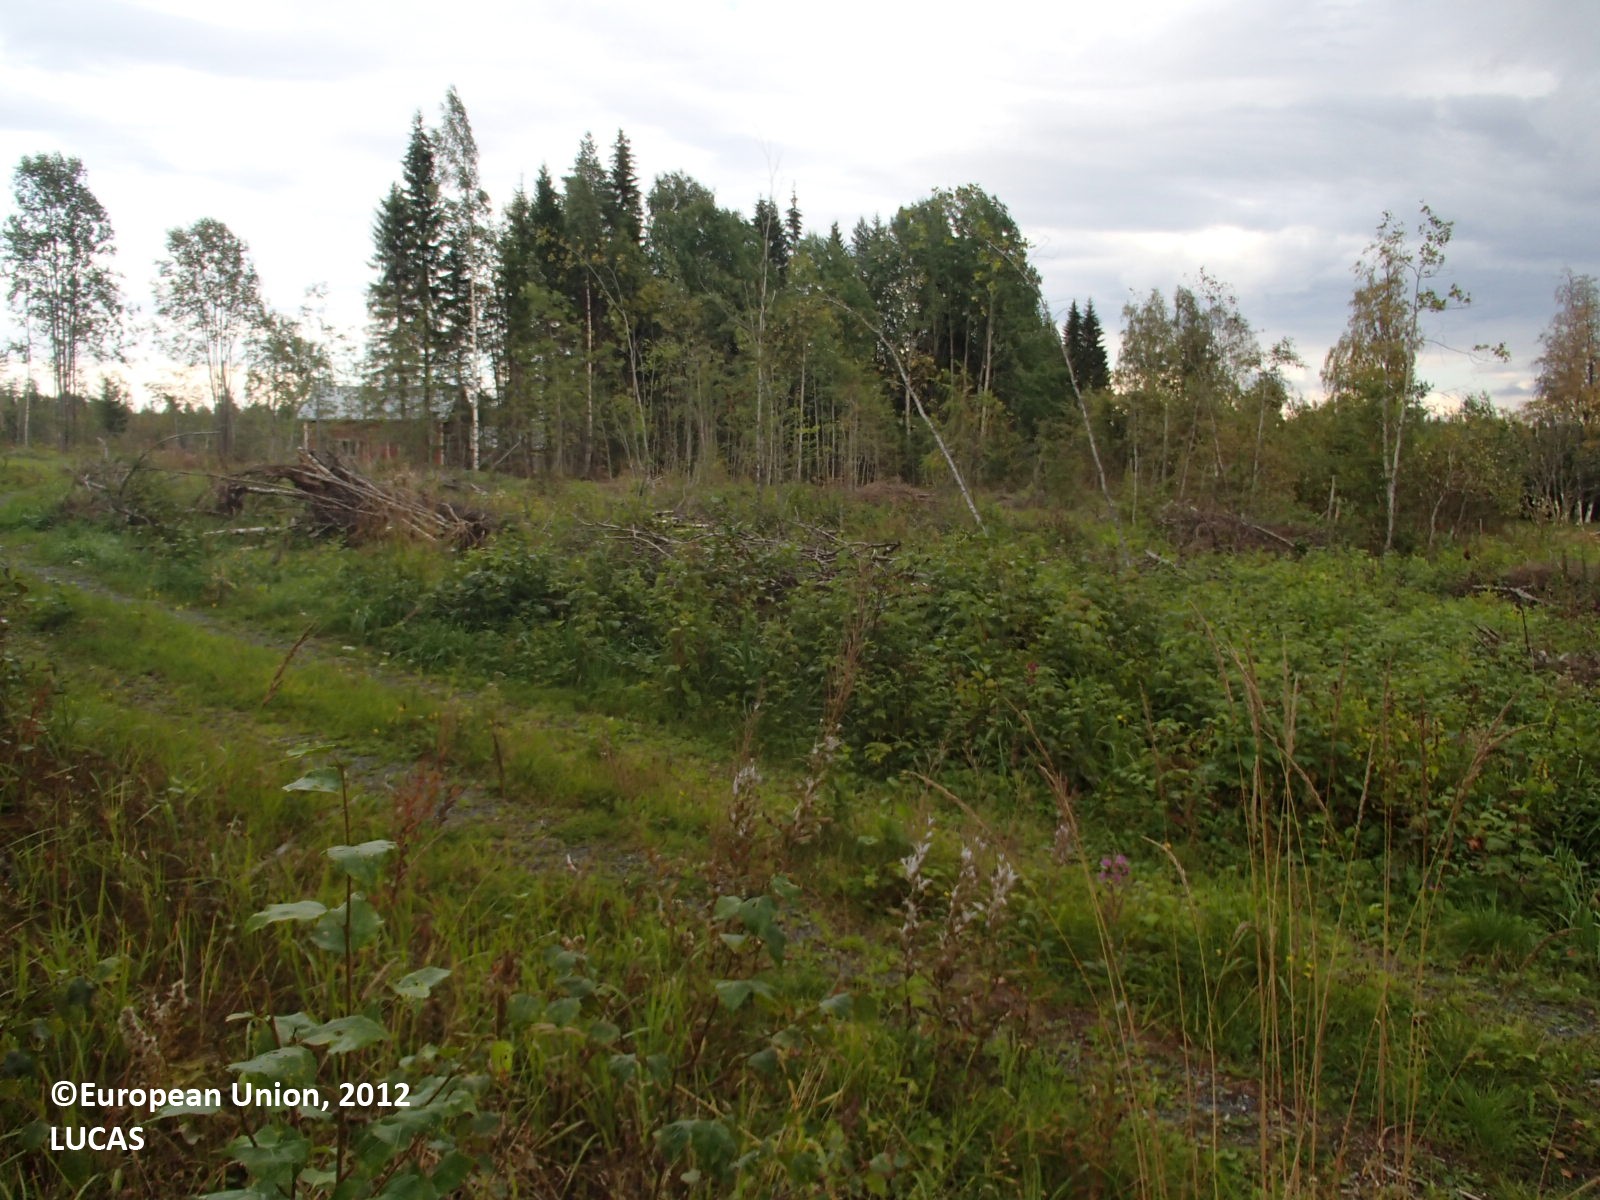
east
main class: Woodland
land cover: Spruce dominated mixed woodland
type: boreal forest
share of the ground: > 75 %
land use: Forestry
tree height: > 5 m
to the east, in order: Spruce dominated mixed woodland; Grass margins; Tracks; Grass margins; Shrubland with sparse tree cover; Artificial constructions in urban areas; Pine dominated mixed woodland; Ditches and canals; Pine dominated mixed woodland; Ditches and canals; Shrubland without tree cover; Ditches and canals; Shrubland without tree cover; Ditches and canals; Shrubland without tree cover
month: August
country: FI
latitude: 63.4769
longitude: 27.1046
